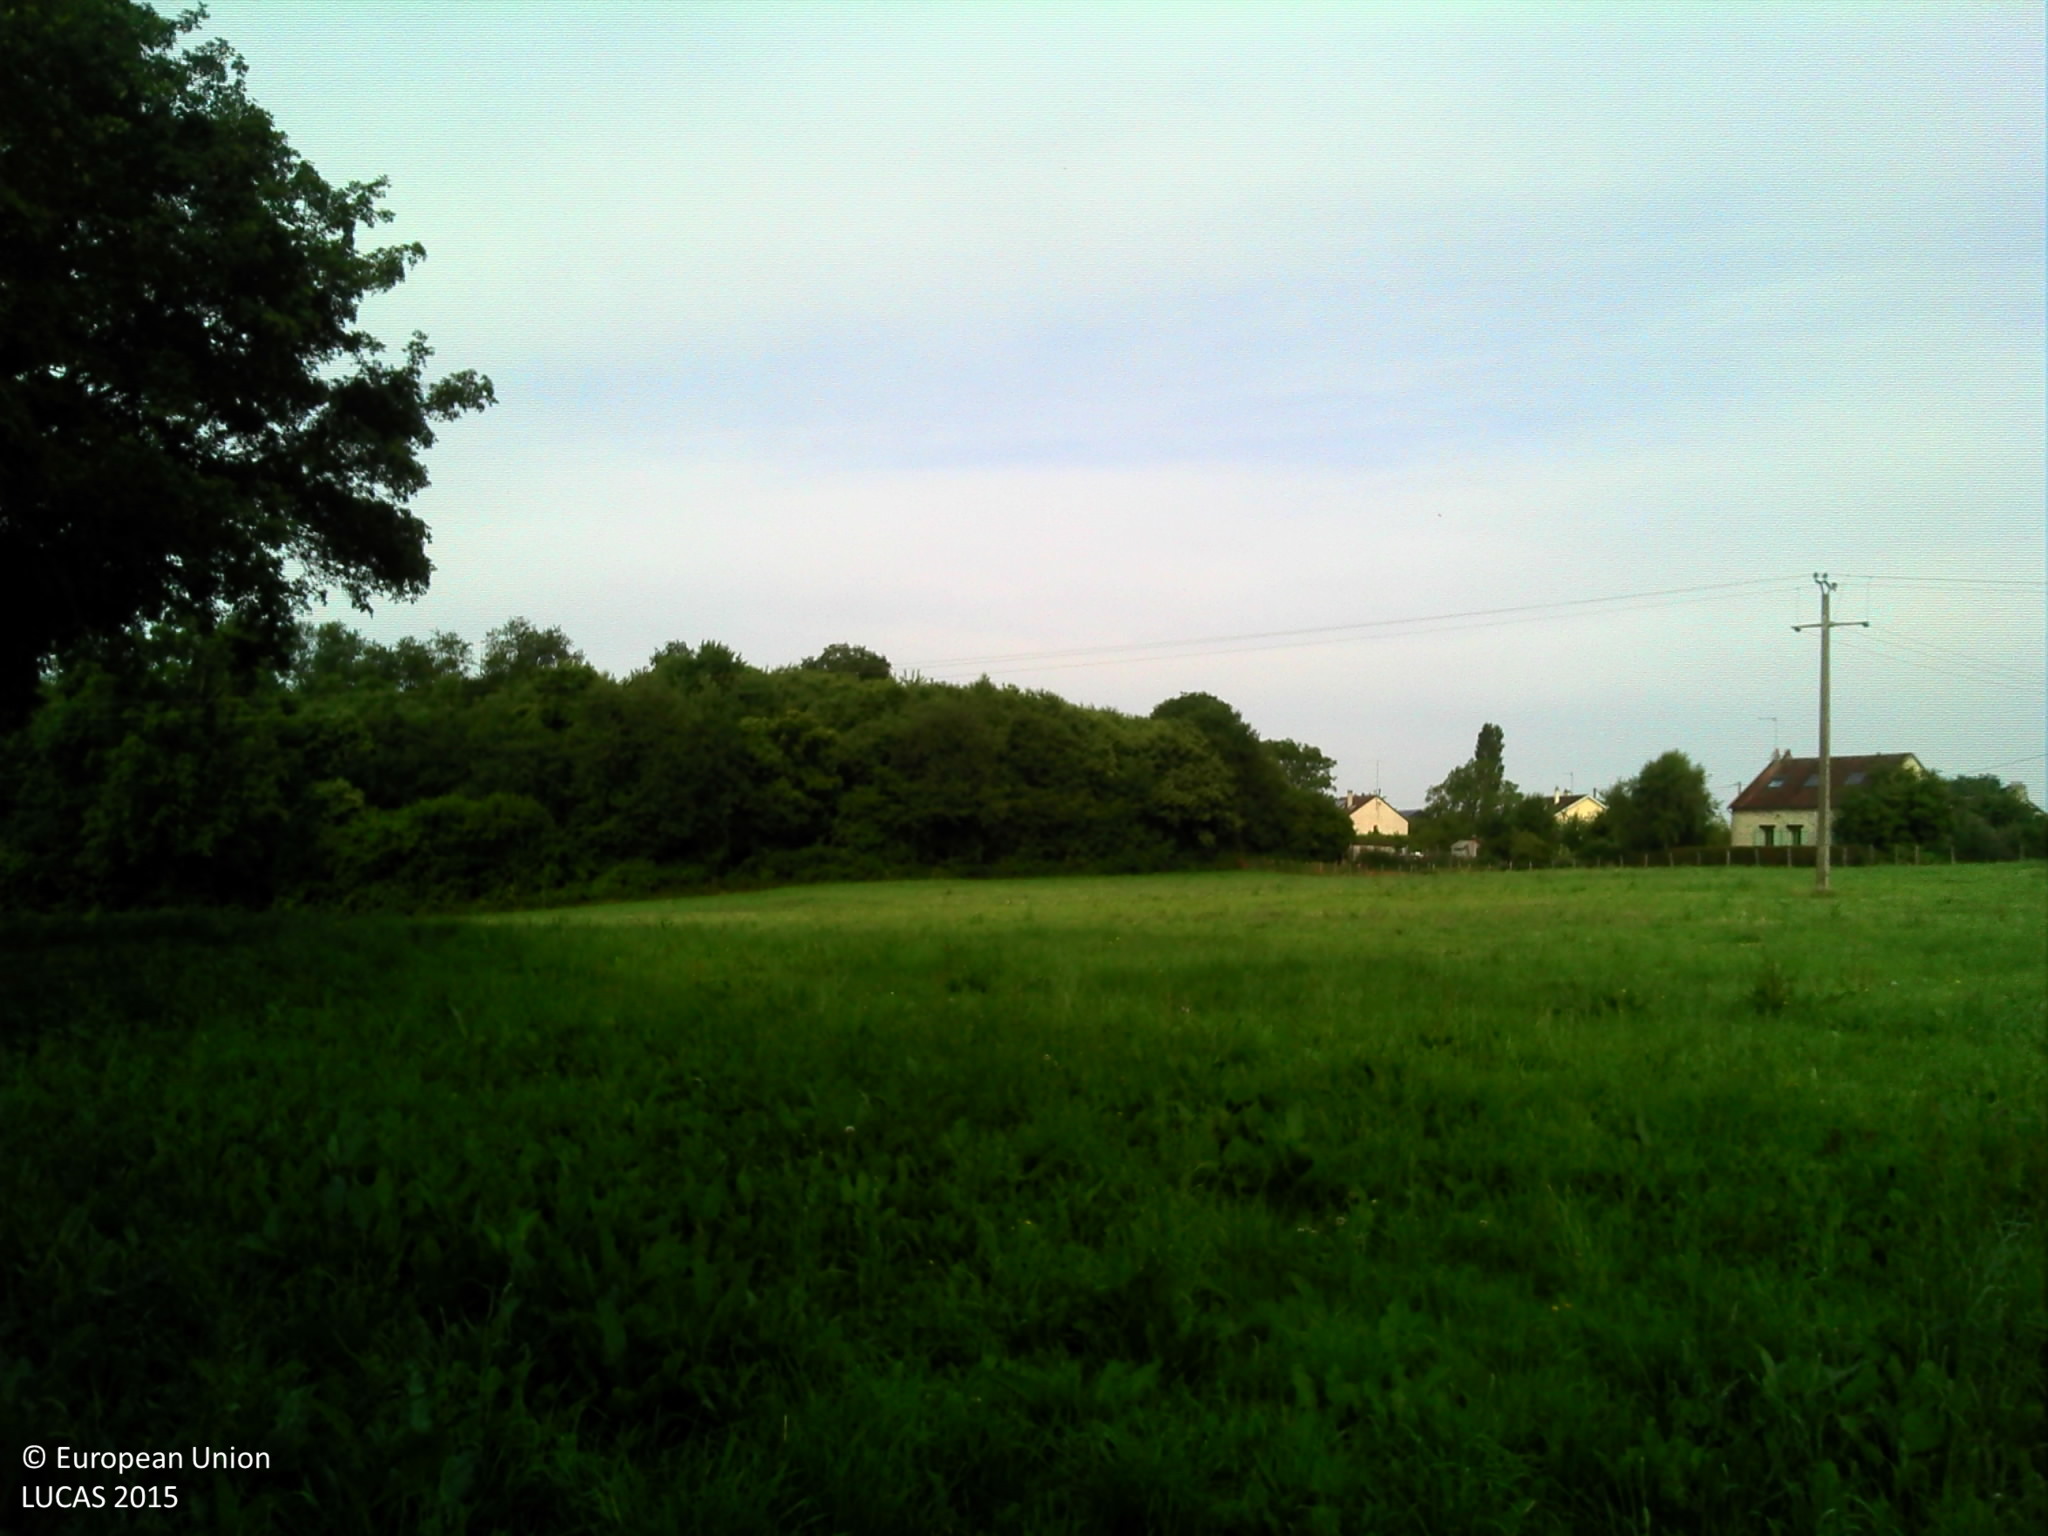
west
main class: Cropland
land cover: Rape and turnip rape
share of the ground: > 75 %
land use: Agriculture (excluding fallow land and kitchen gardens)
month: June
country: FR
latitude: 48.3623
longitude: 0.1599
